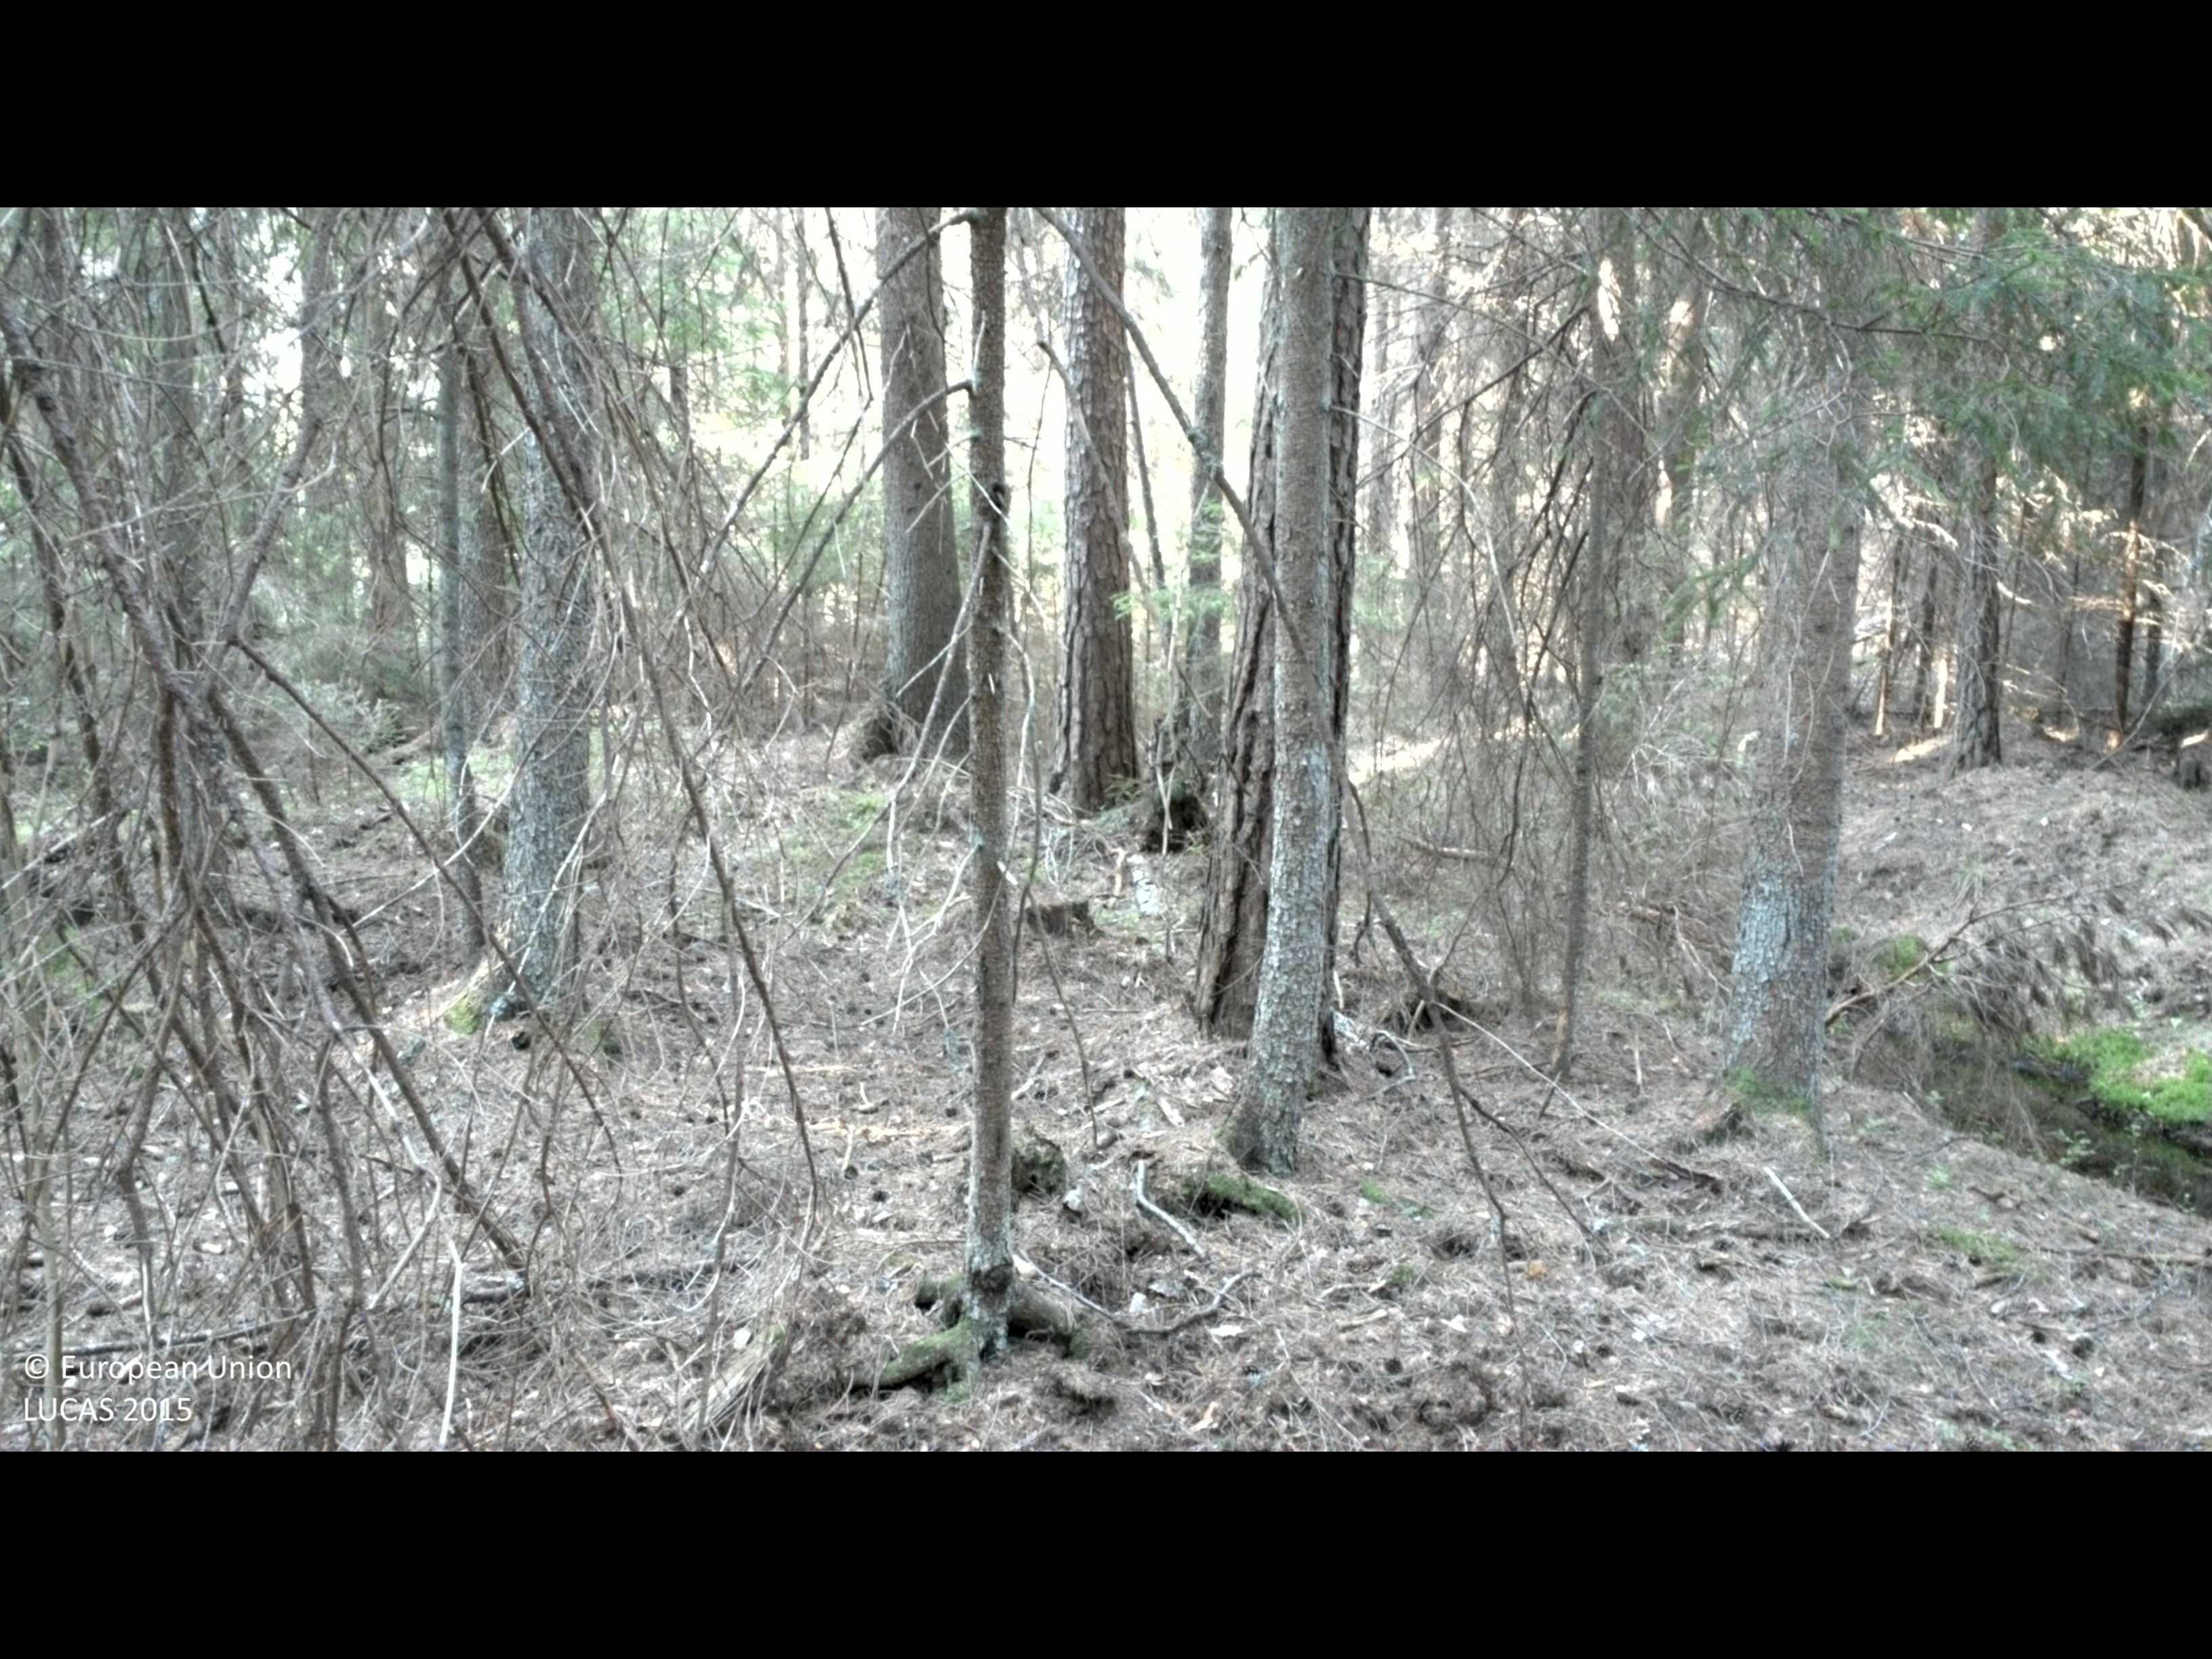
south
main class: Woodland
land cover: Spruce dominated coniferous woodland
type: boreal forest
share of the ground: > 75 %
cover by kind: coniferous forest trees 85 %, shrubs 10 %, lichens and mosses 5 %
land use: Forestry
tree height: > 5 m
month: July
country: SE
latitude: 58.2547
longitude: 16.6260
